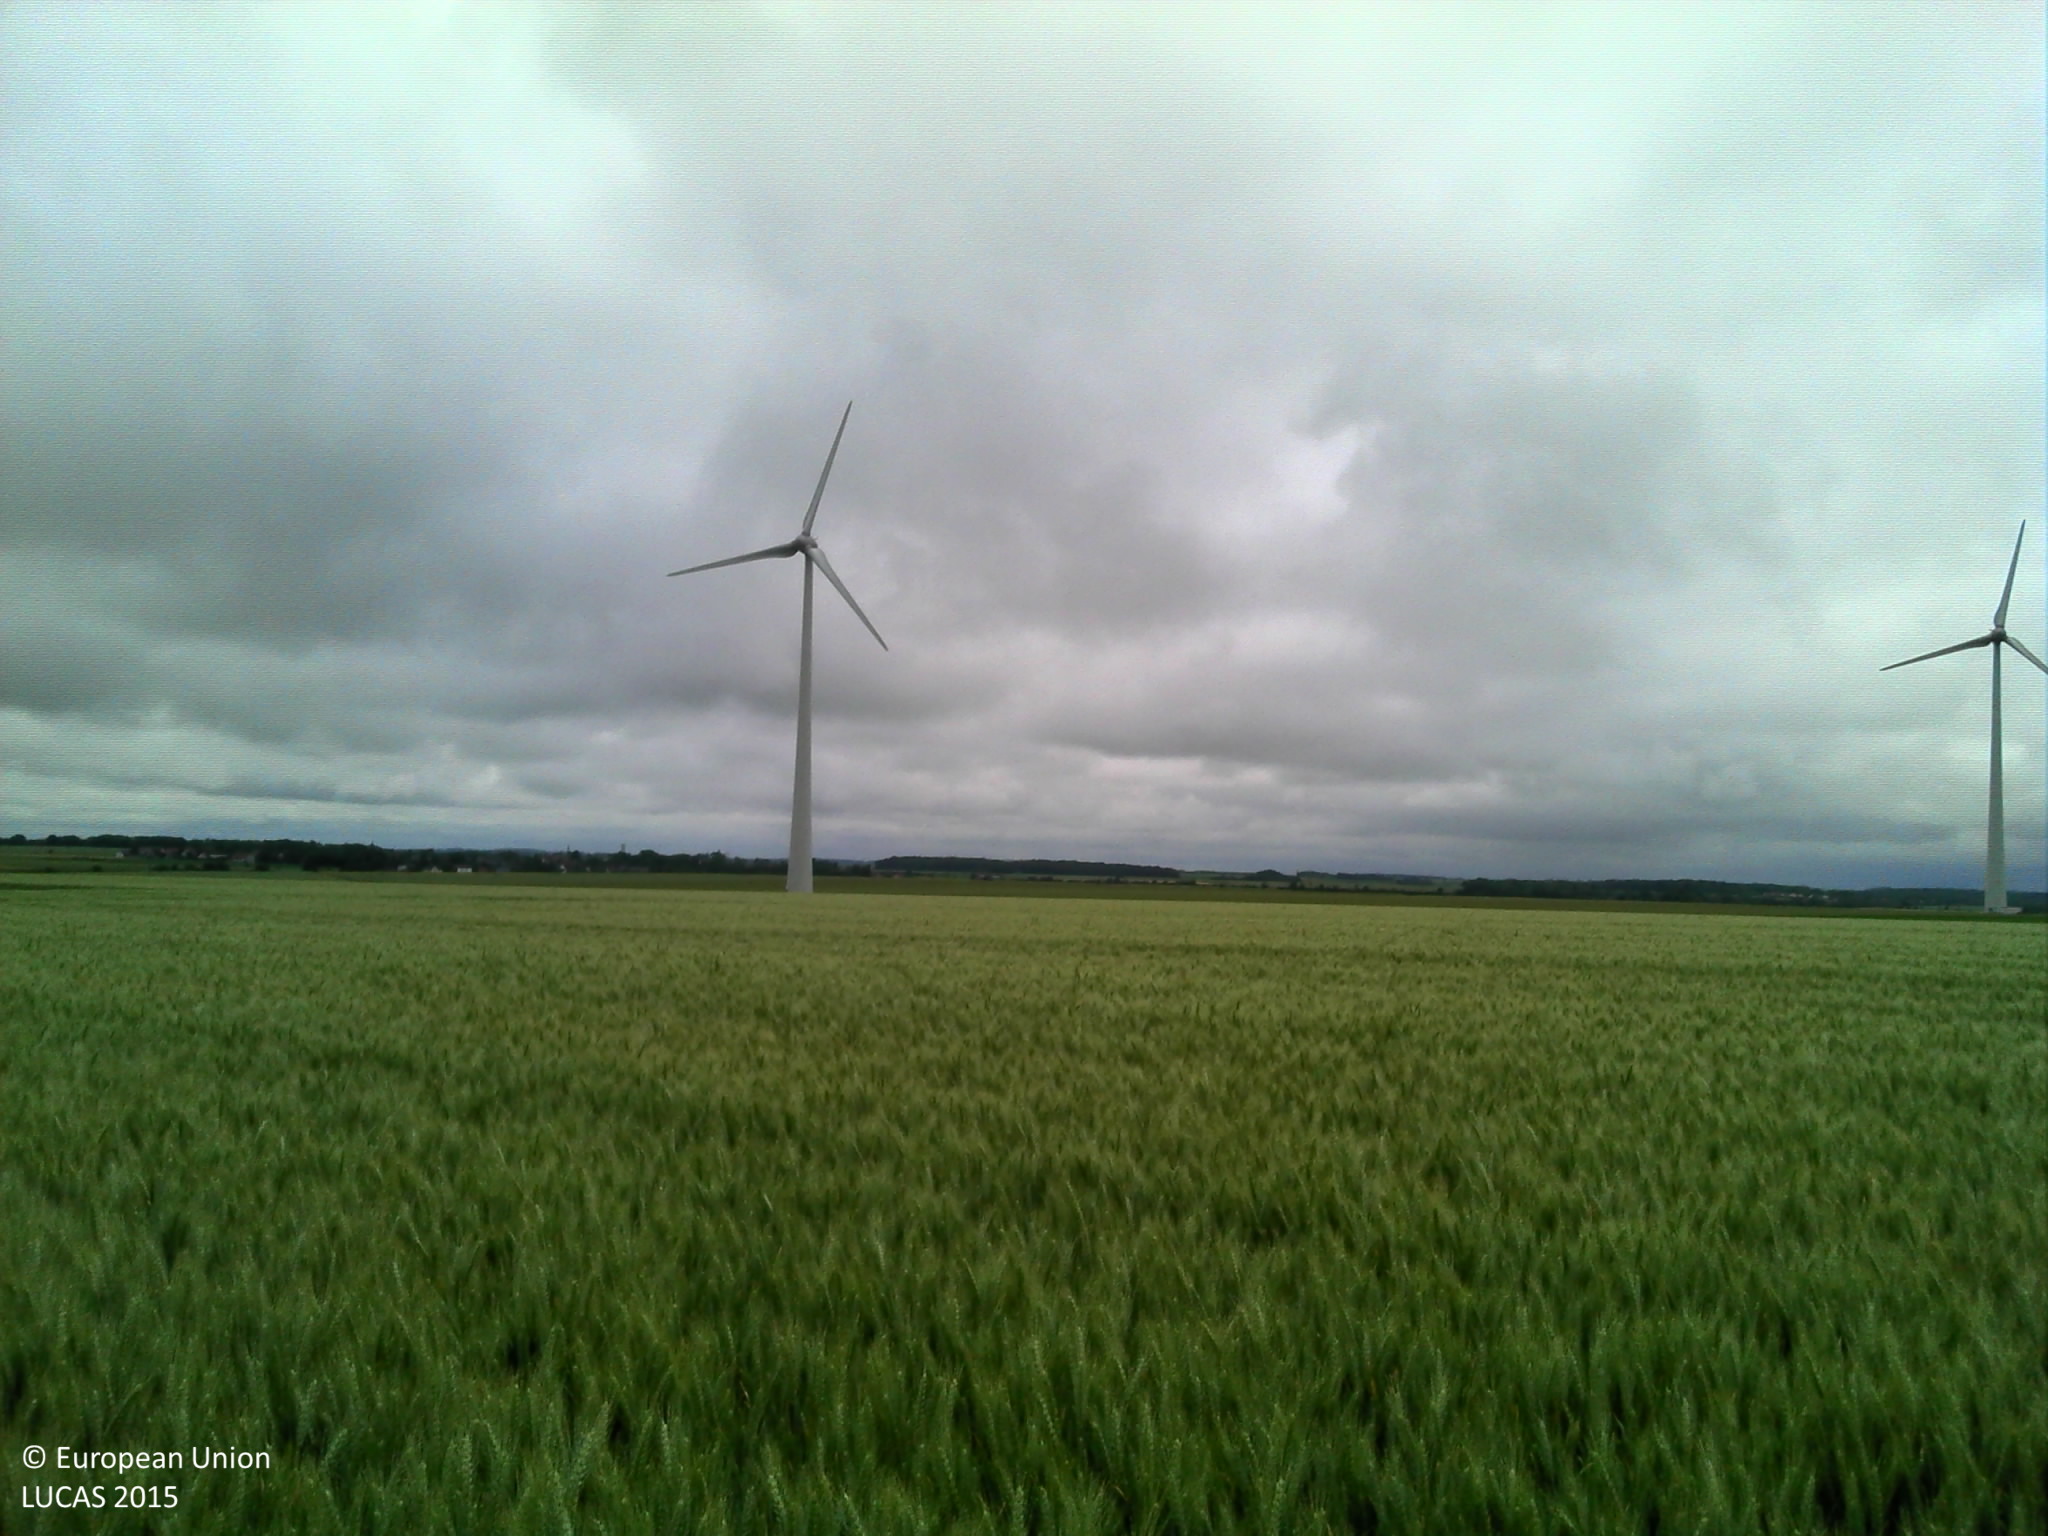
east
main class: Cropland
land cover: Barley
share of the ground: > 75 %
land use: Agriculture (excluding fallow land and kitchen gardens)
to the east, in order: Barley
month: June
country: FR
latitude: 49.5510
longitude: 2.3989
